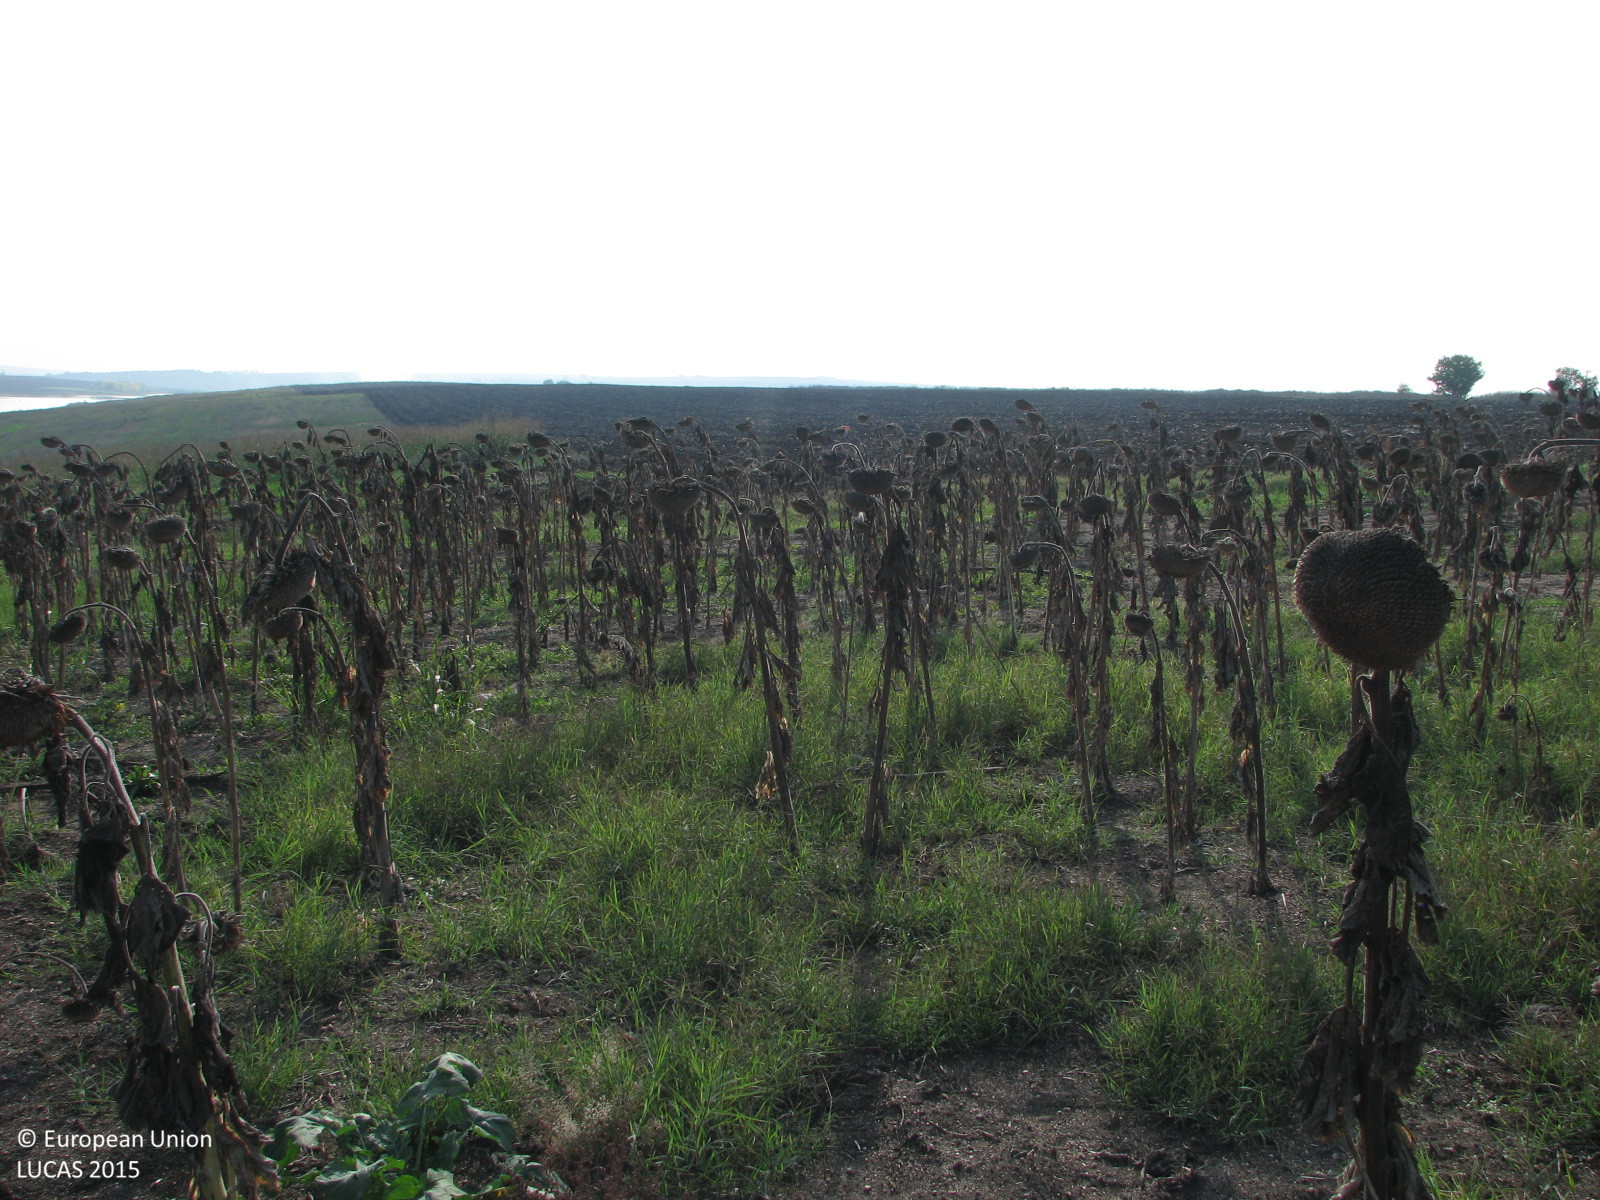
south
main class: Cropland
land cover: Sunflower
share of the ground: > 75 %
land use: Agriculture (excluding fallow land and kitchen gardens)
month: October
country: BG
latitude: 42.3481
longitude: 26.4404
